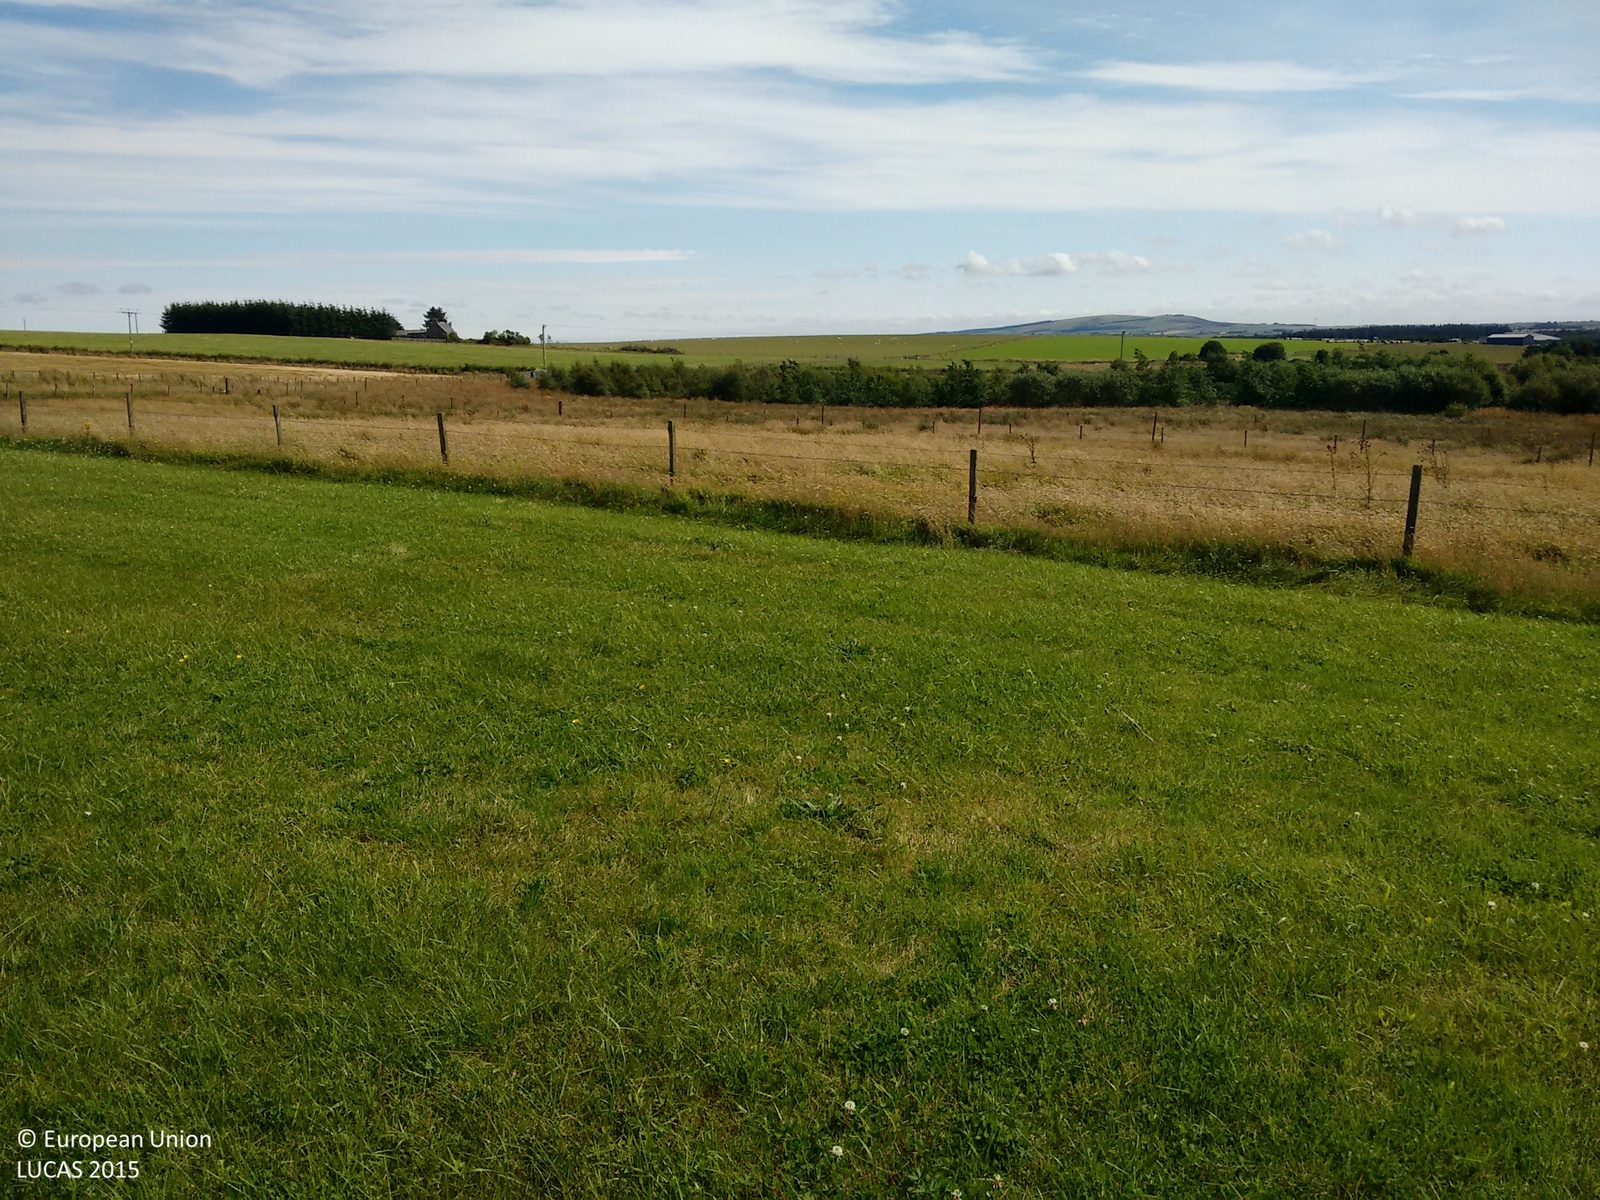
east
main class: Grassland
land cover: Grassland without tree/shrub cover
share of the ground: > 75 %
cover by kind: herbaceous plants 100 %
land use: Agriculture (excluding fallow land and kitchen gardens)
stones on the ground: 10 - 25 %
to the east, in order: Grassland without tree/shrub cover; Fences; Grassland without tree/shrub cover; Fences; Inland marshes; Ditches and canals; Broadleaved woodland; Grassland without tree/shrub cover; Electric lines; Fences; Grass margins; Fences; Grass margins; Ditches and canals; Grass margins; Fences; Grassland without tree/shrub cover
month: August
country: GB
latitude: 57.6228
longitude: -2.2203
